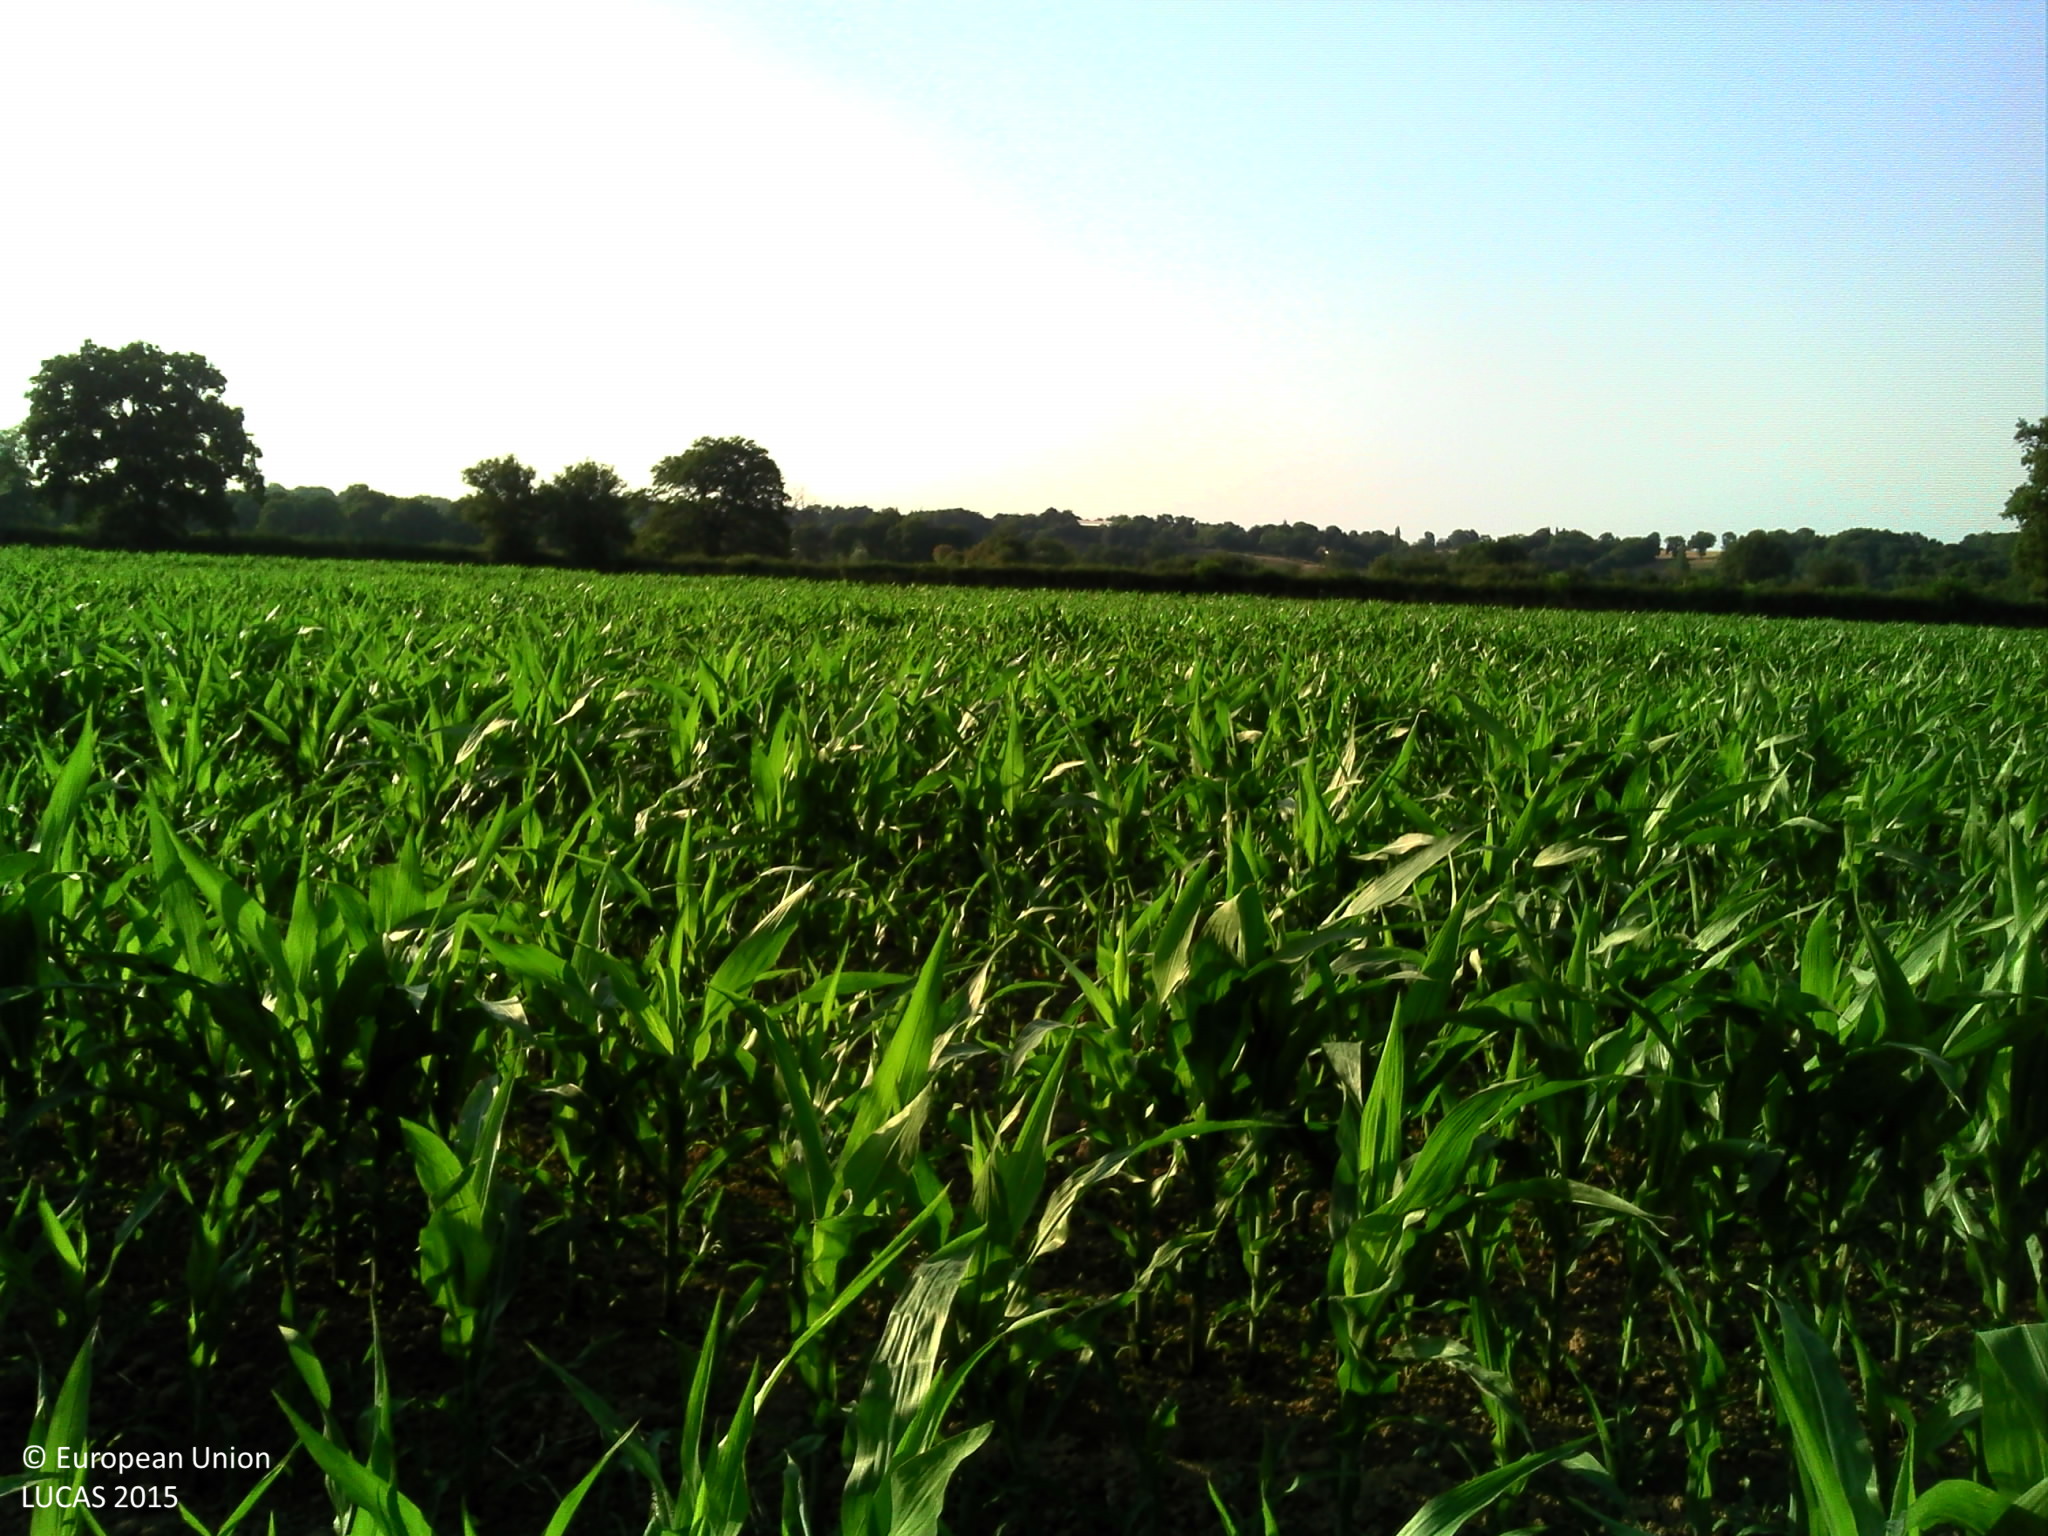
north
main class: Cropland
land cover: Maize
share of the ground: > 75 %
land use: Agriculture (excluding fallow land and kitchen gardens)
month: July
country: FR
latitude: 46.7897
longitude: 3.5662
